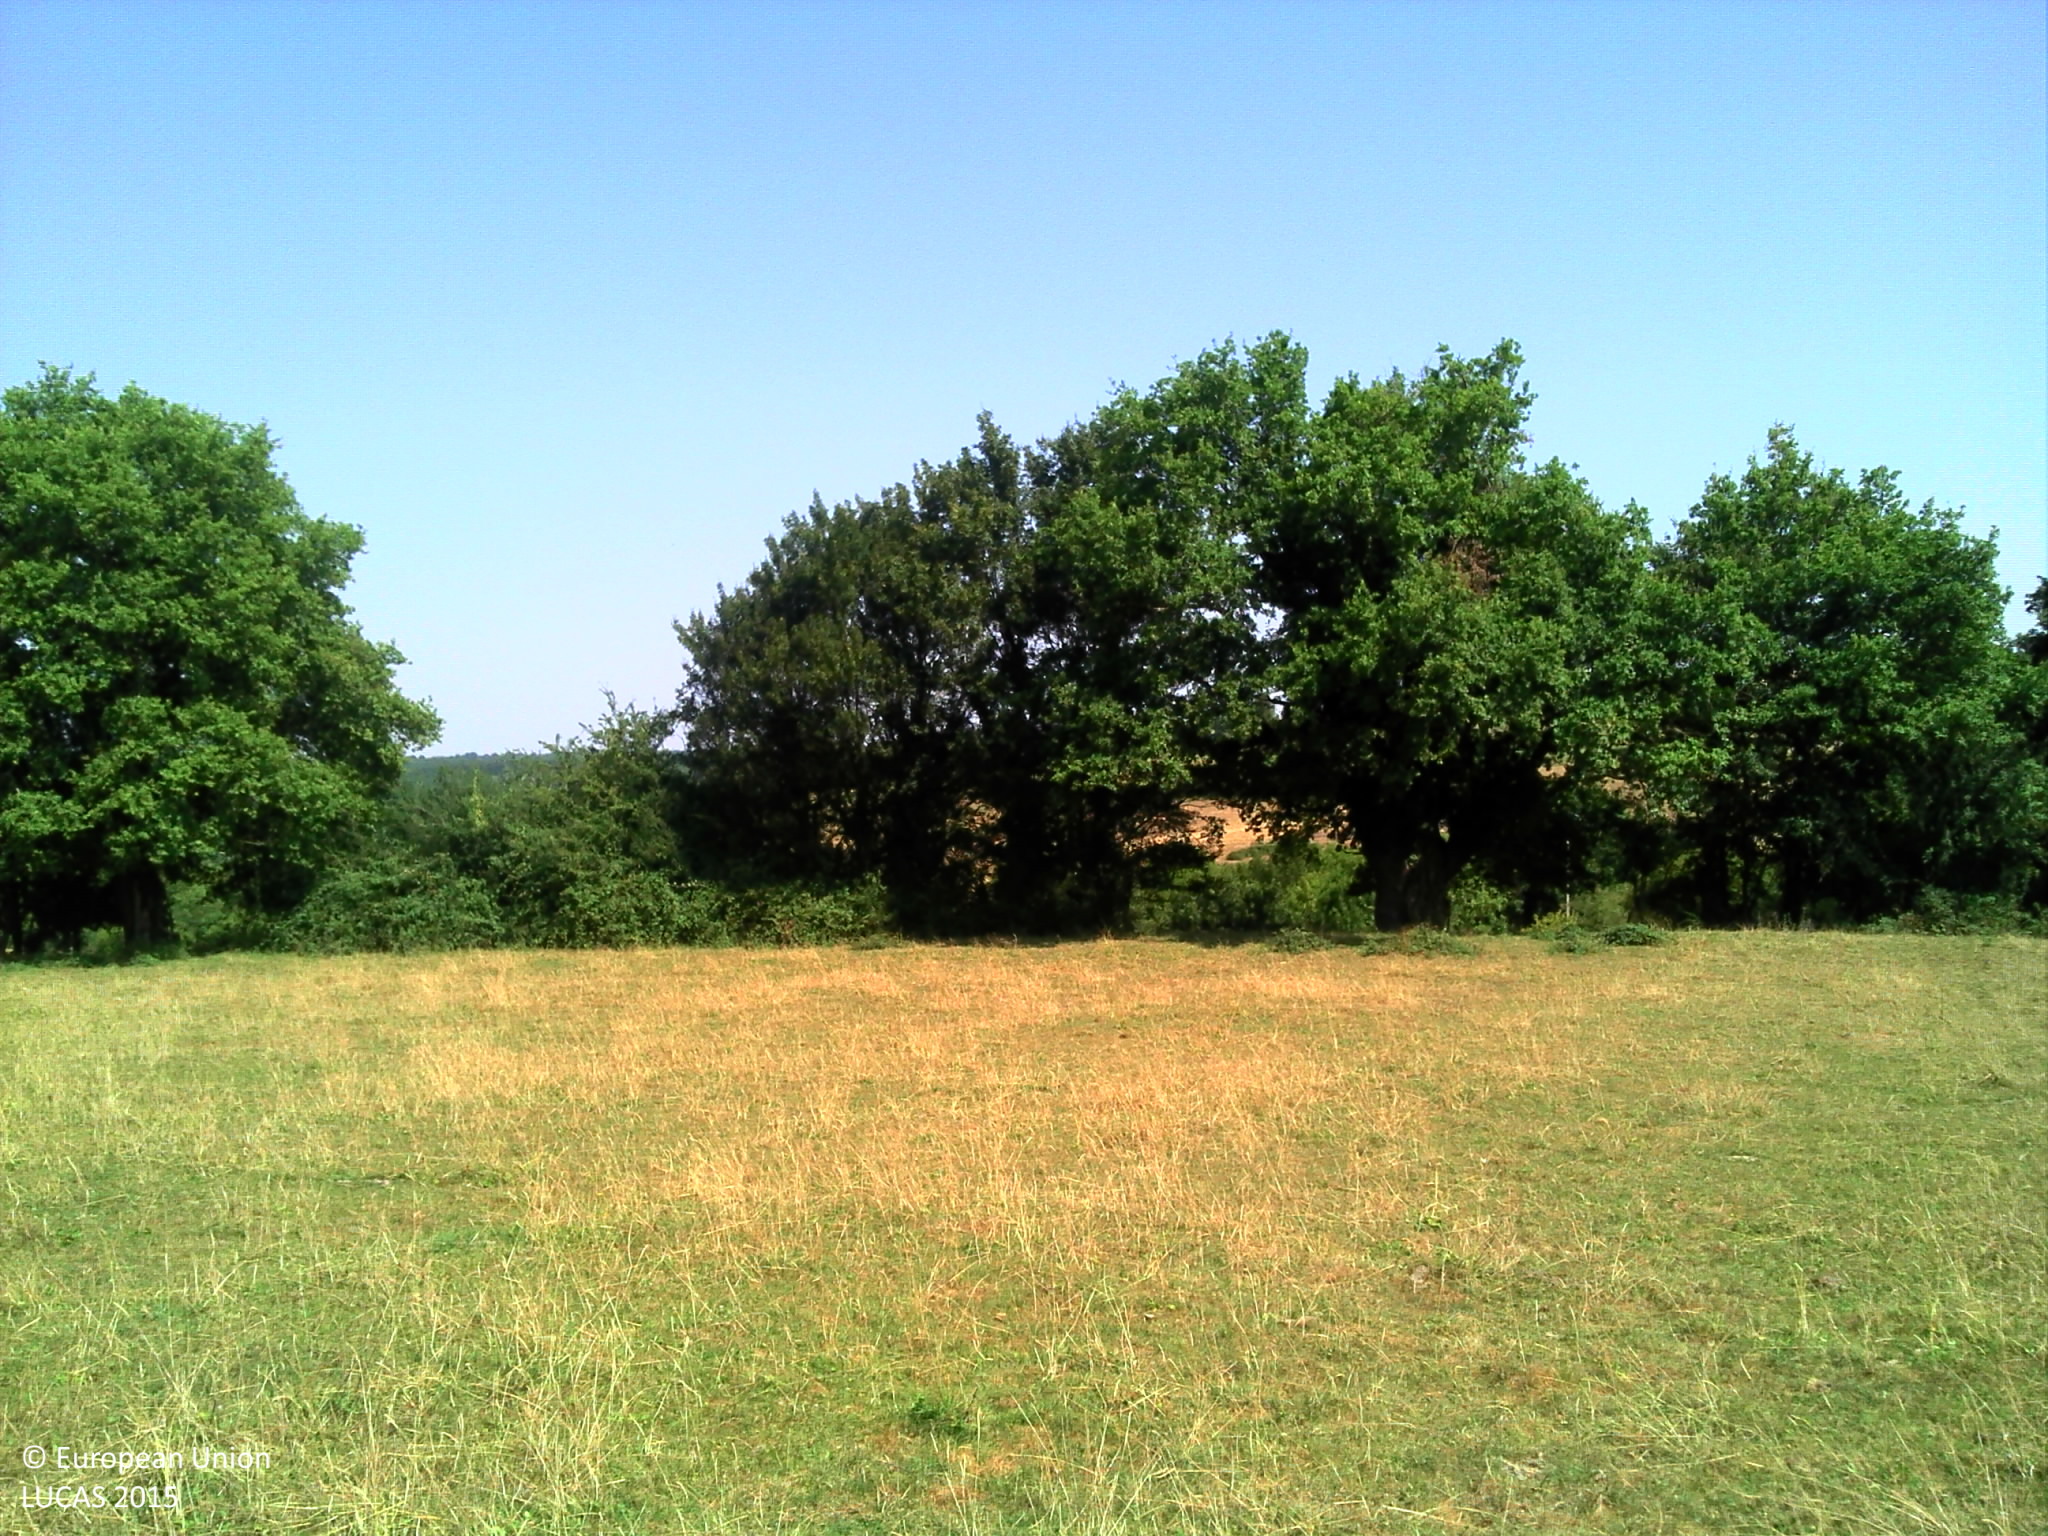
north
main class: Grassland
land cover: Grassland without tree/shrub cover
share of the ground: > 75 %
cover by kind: herbaceous plants 100 %
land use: Agriculture (excluding fallow land and kitchen gardens)
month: July
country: FR
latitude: 46.4851
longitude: 3.0280
